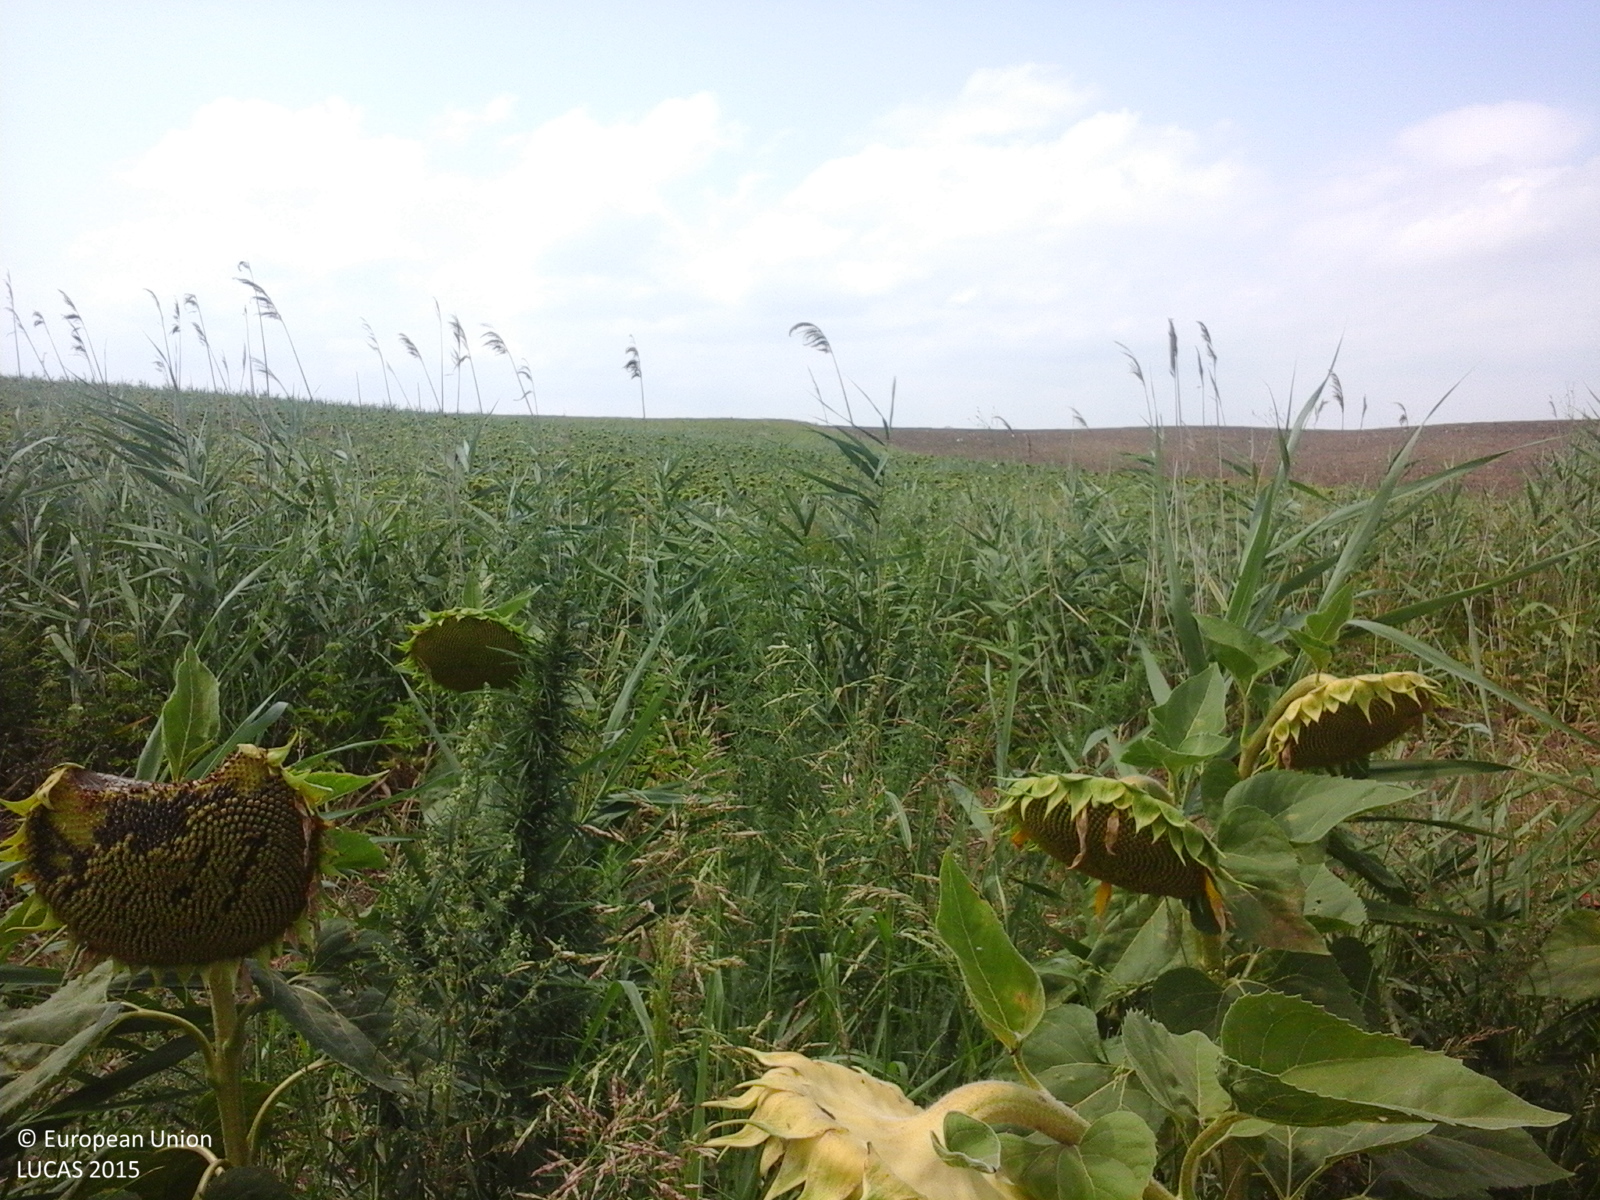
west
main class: Cropland
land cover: Sunflower
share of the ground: > 75 %
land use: Agriculture (excluding fallow land and kitchen gardens)
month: July
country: RO
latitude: 45.2119
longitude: 28.5311
